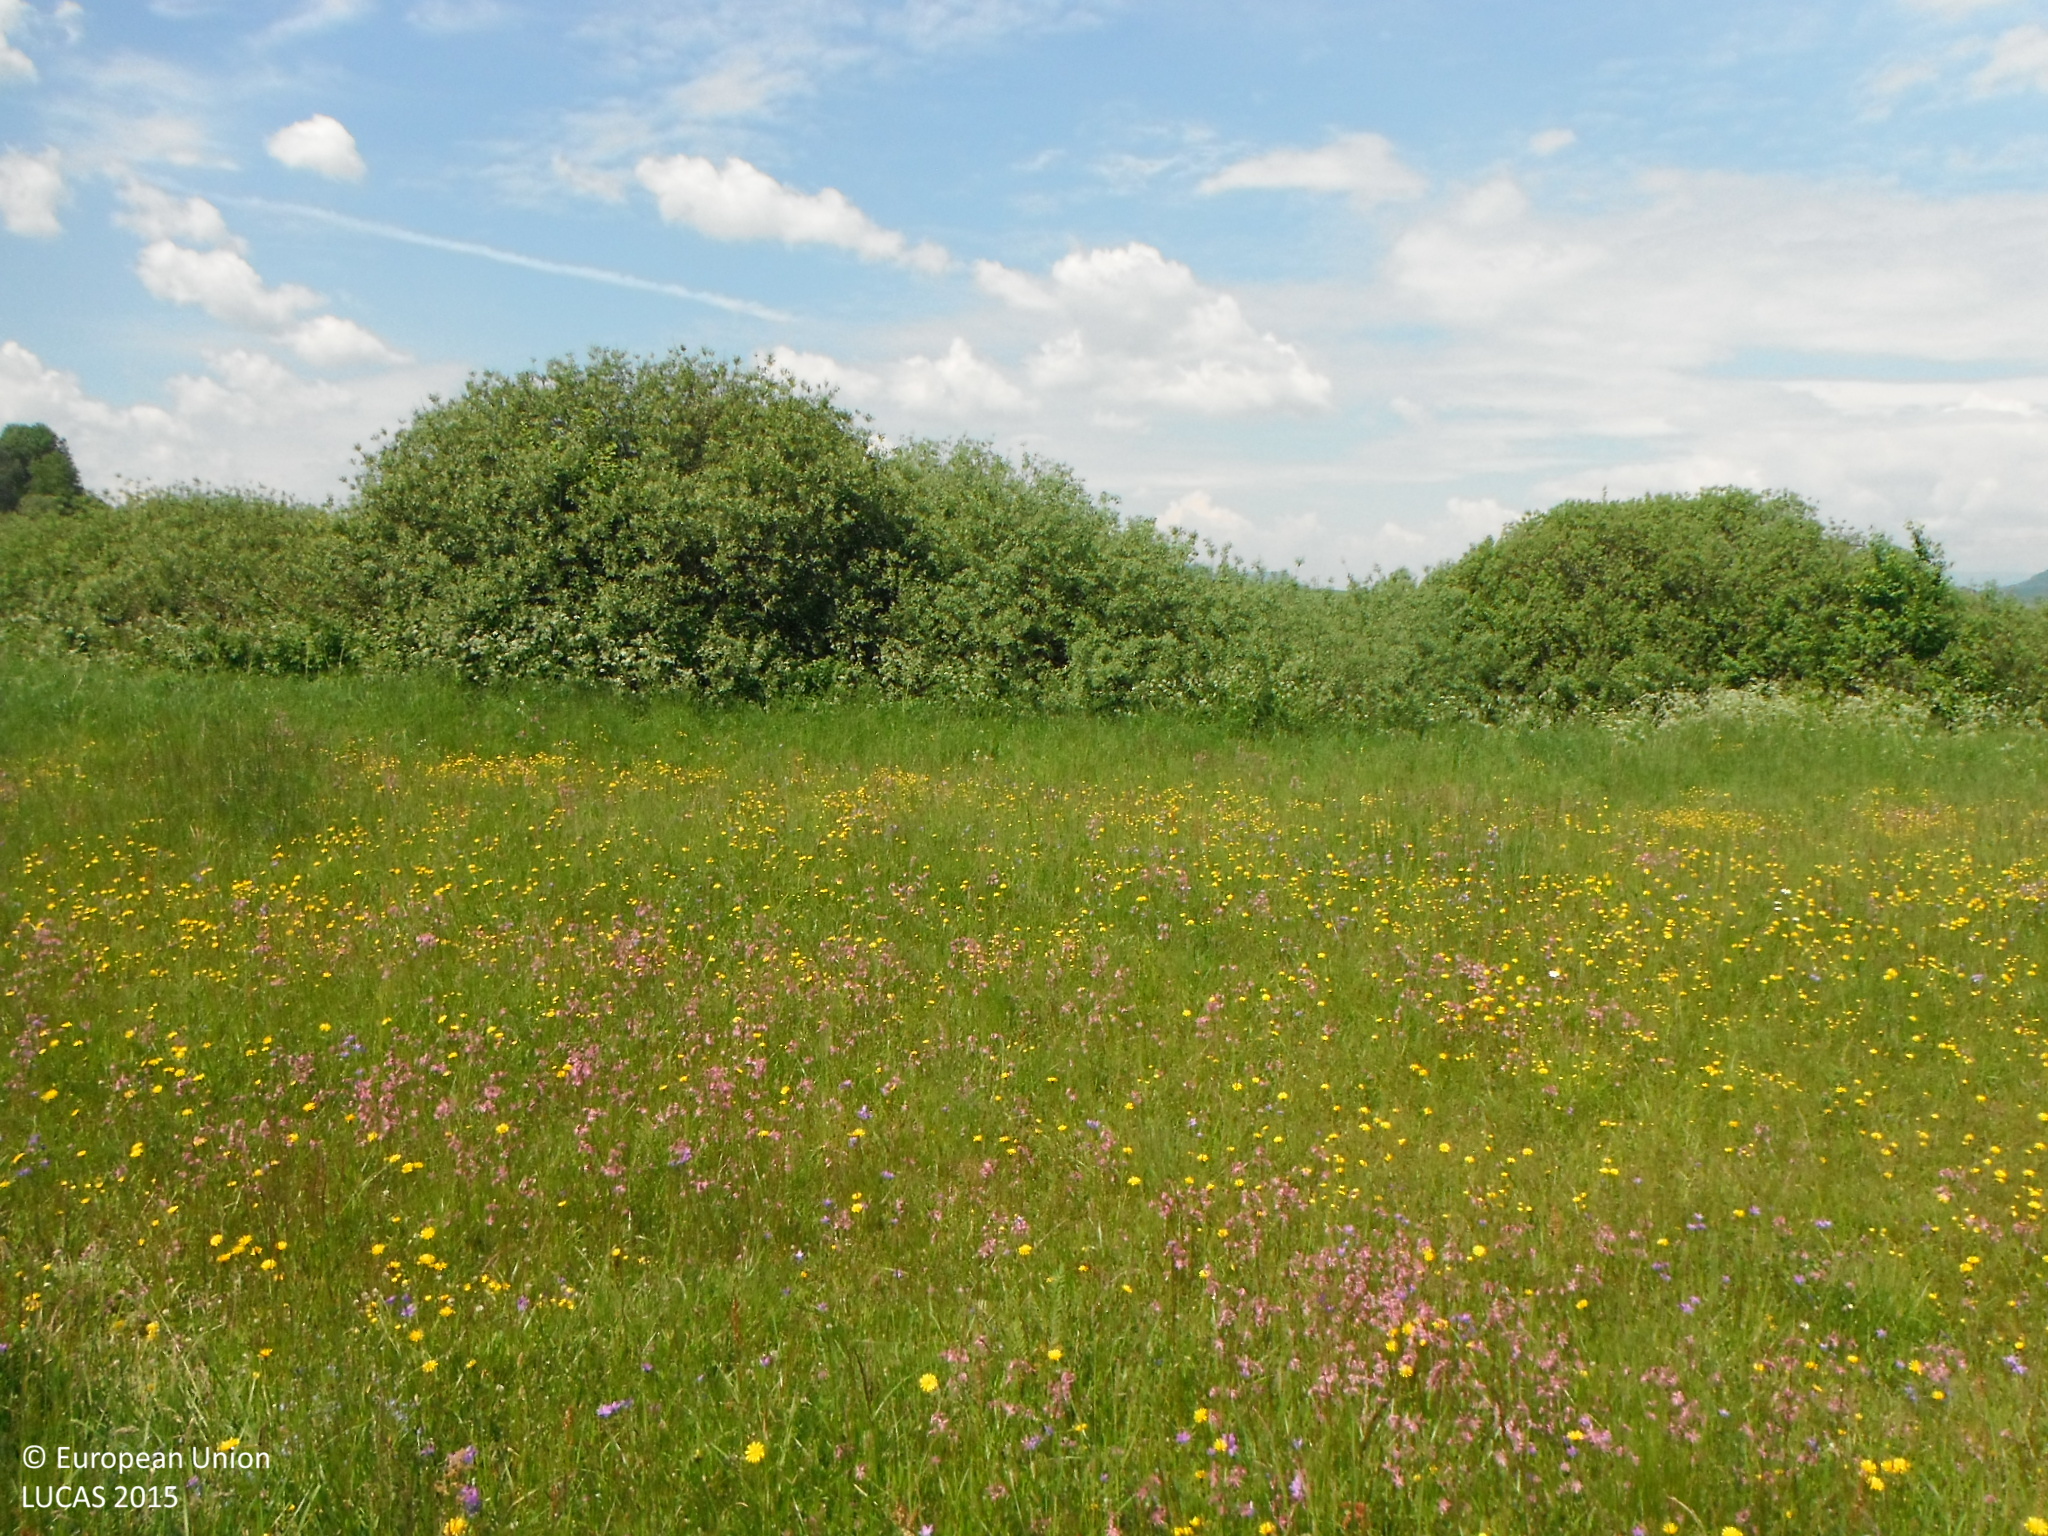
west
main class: Grassland
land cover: Grassland without tree/shrub cover
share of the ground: > 75 %
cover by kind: herbaceous plants 100 %
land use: Agriculture (excluding fallow land and kitchen gardens)
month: June
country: SK
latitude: 48.7910
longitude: 19.7054
